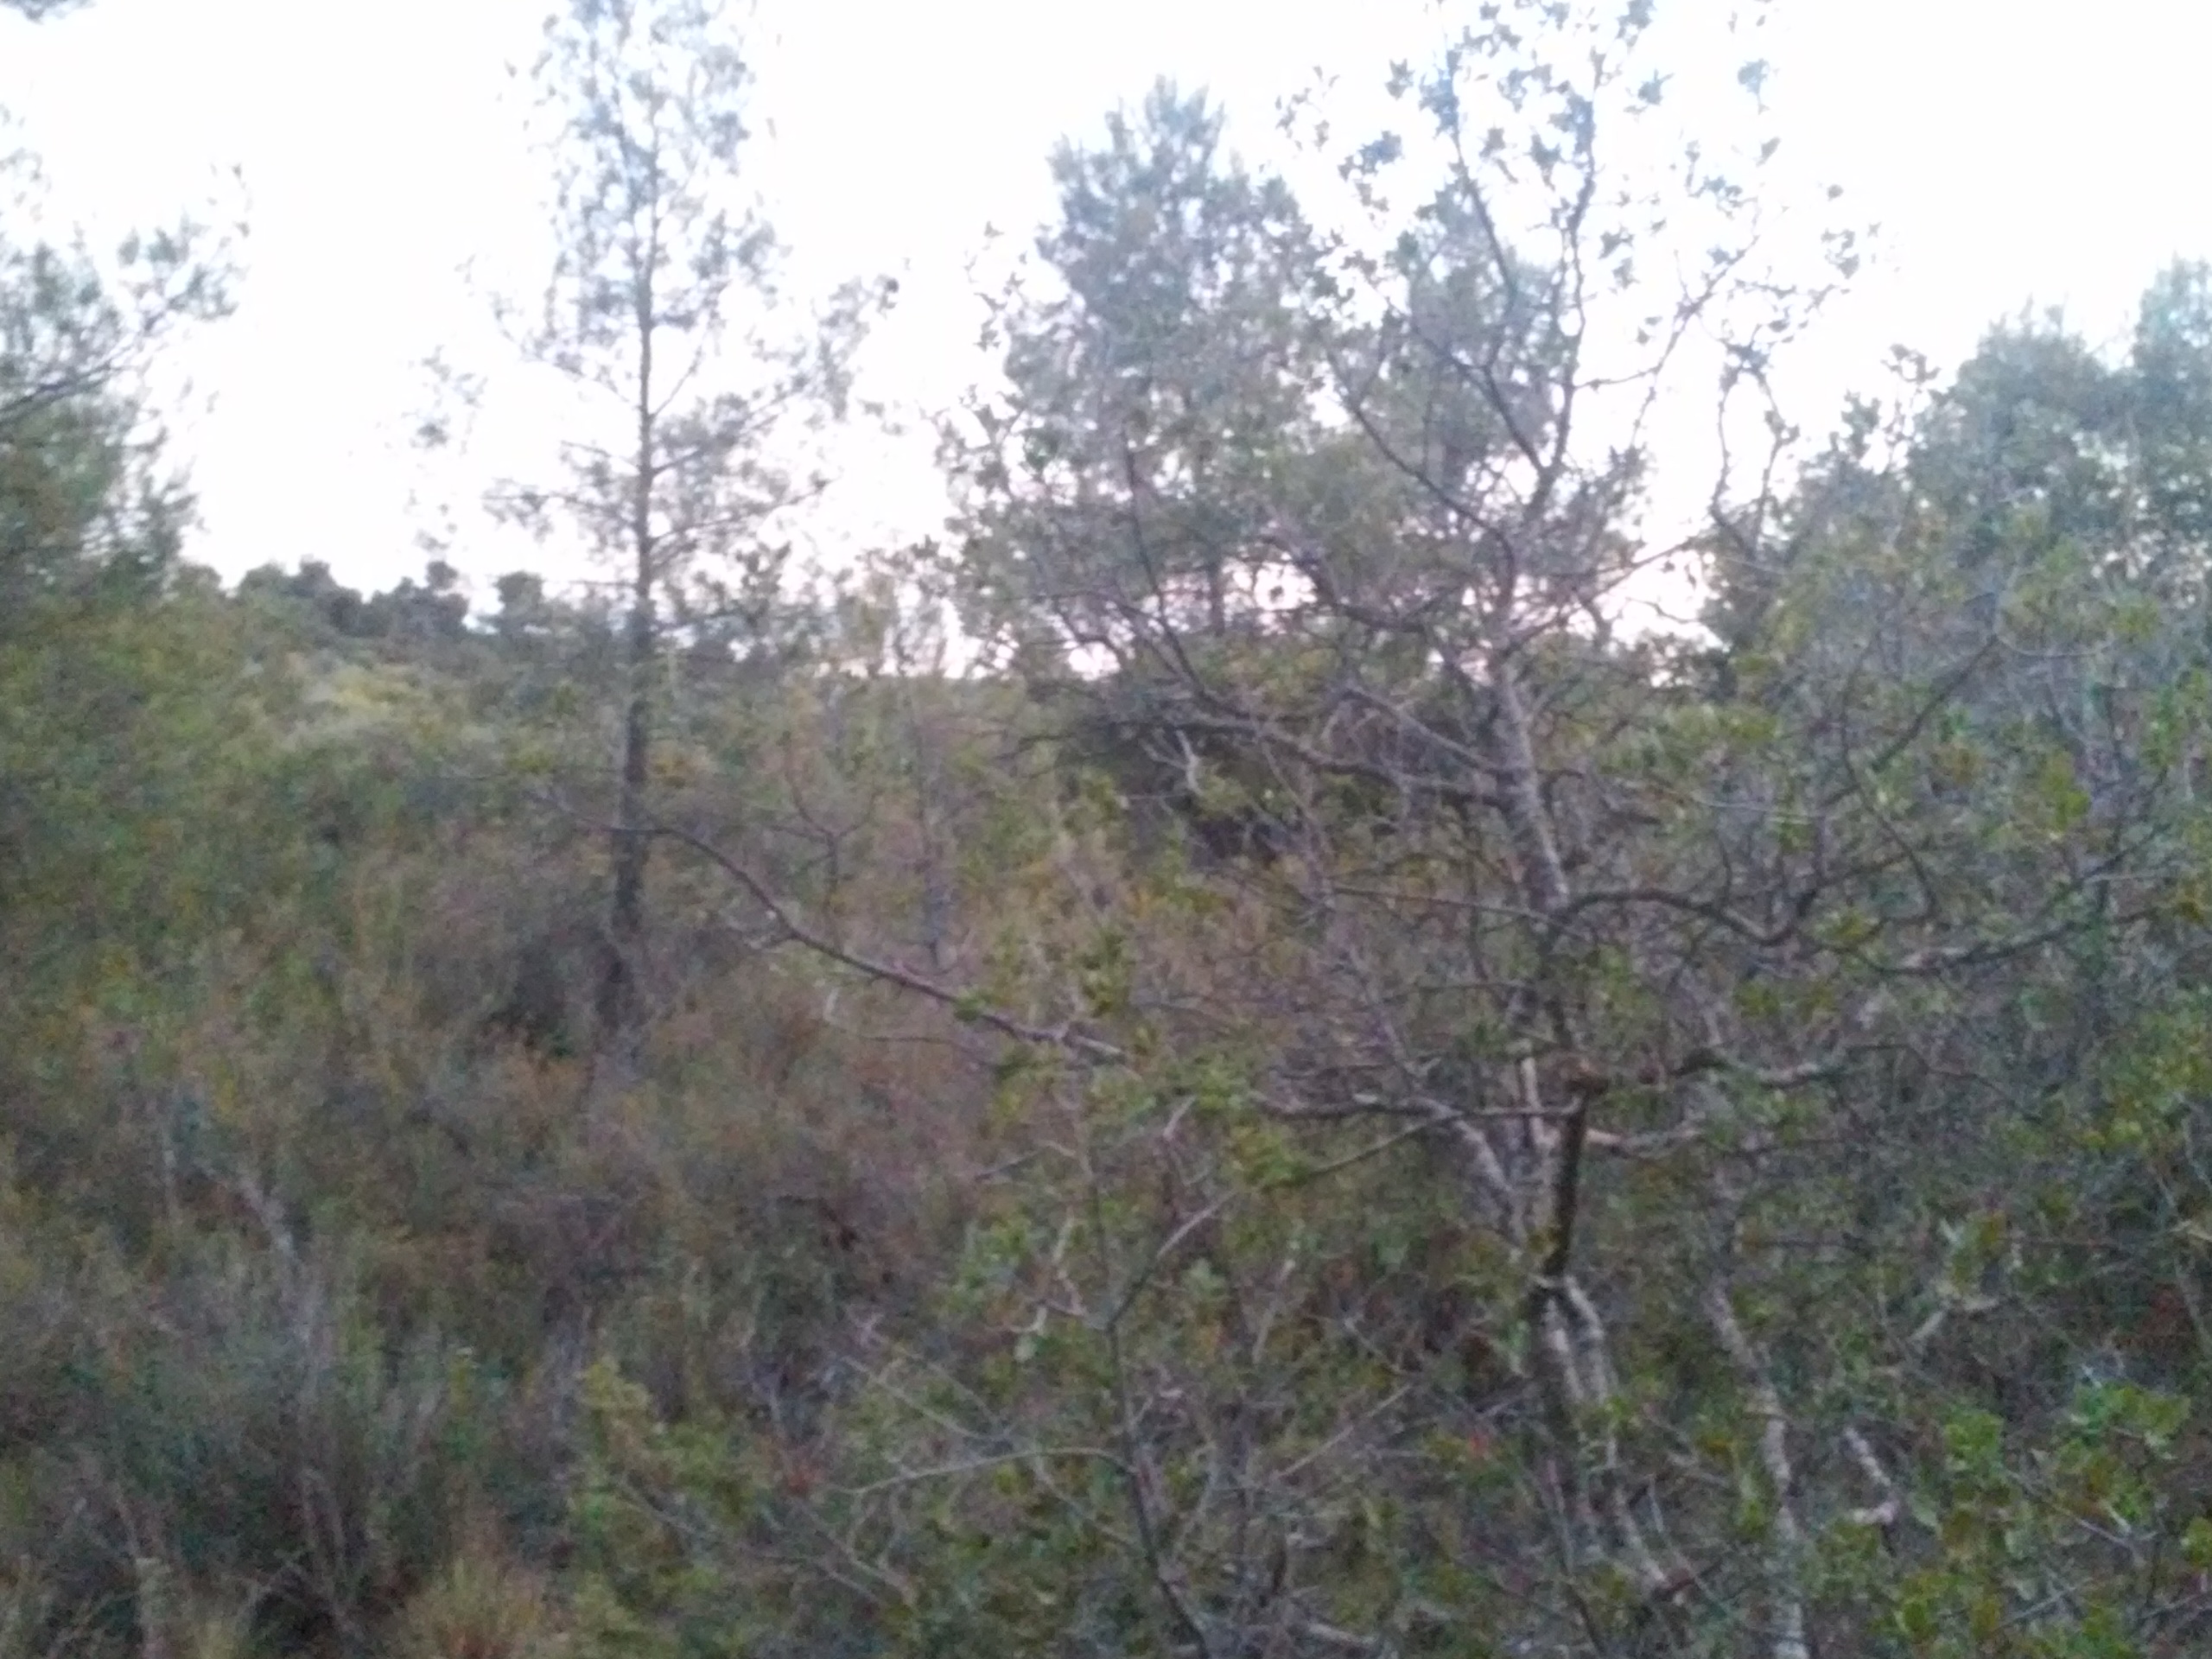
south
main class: Woodland
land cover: Pine dominated coniferous woodland
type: coniferous forest of the mediterranean region
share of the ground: 10 - 25 %
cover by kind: consolidated bare surface 30 %, shrubs 25 %, coniferous forest trees 20 %, herbaceous plants 20 %, broadleaved forest trees 5 %
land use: Semi-natural and natural areas not in use
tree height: < 5 m
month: August
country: ES
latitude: 41.4136
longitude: 0.7660
